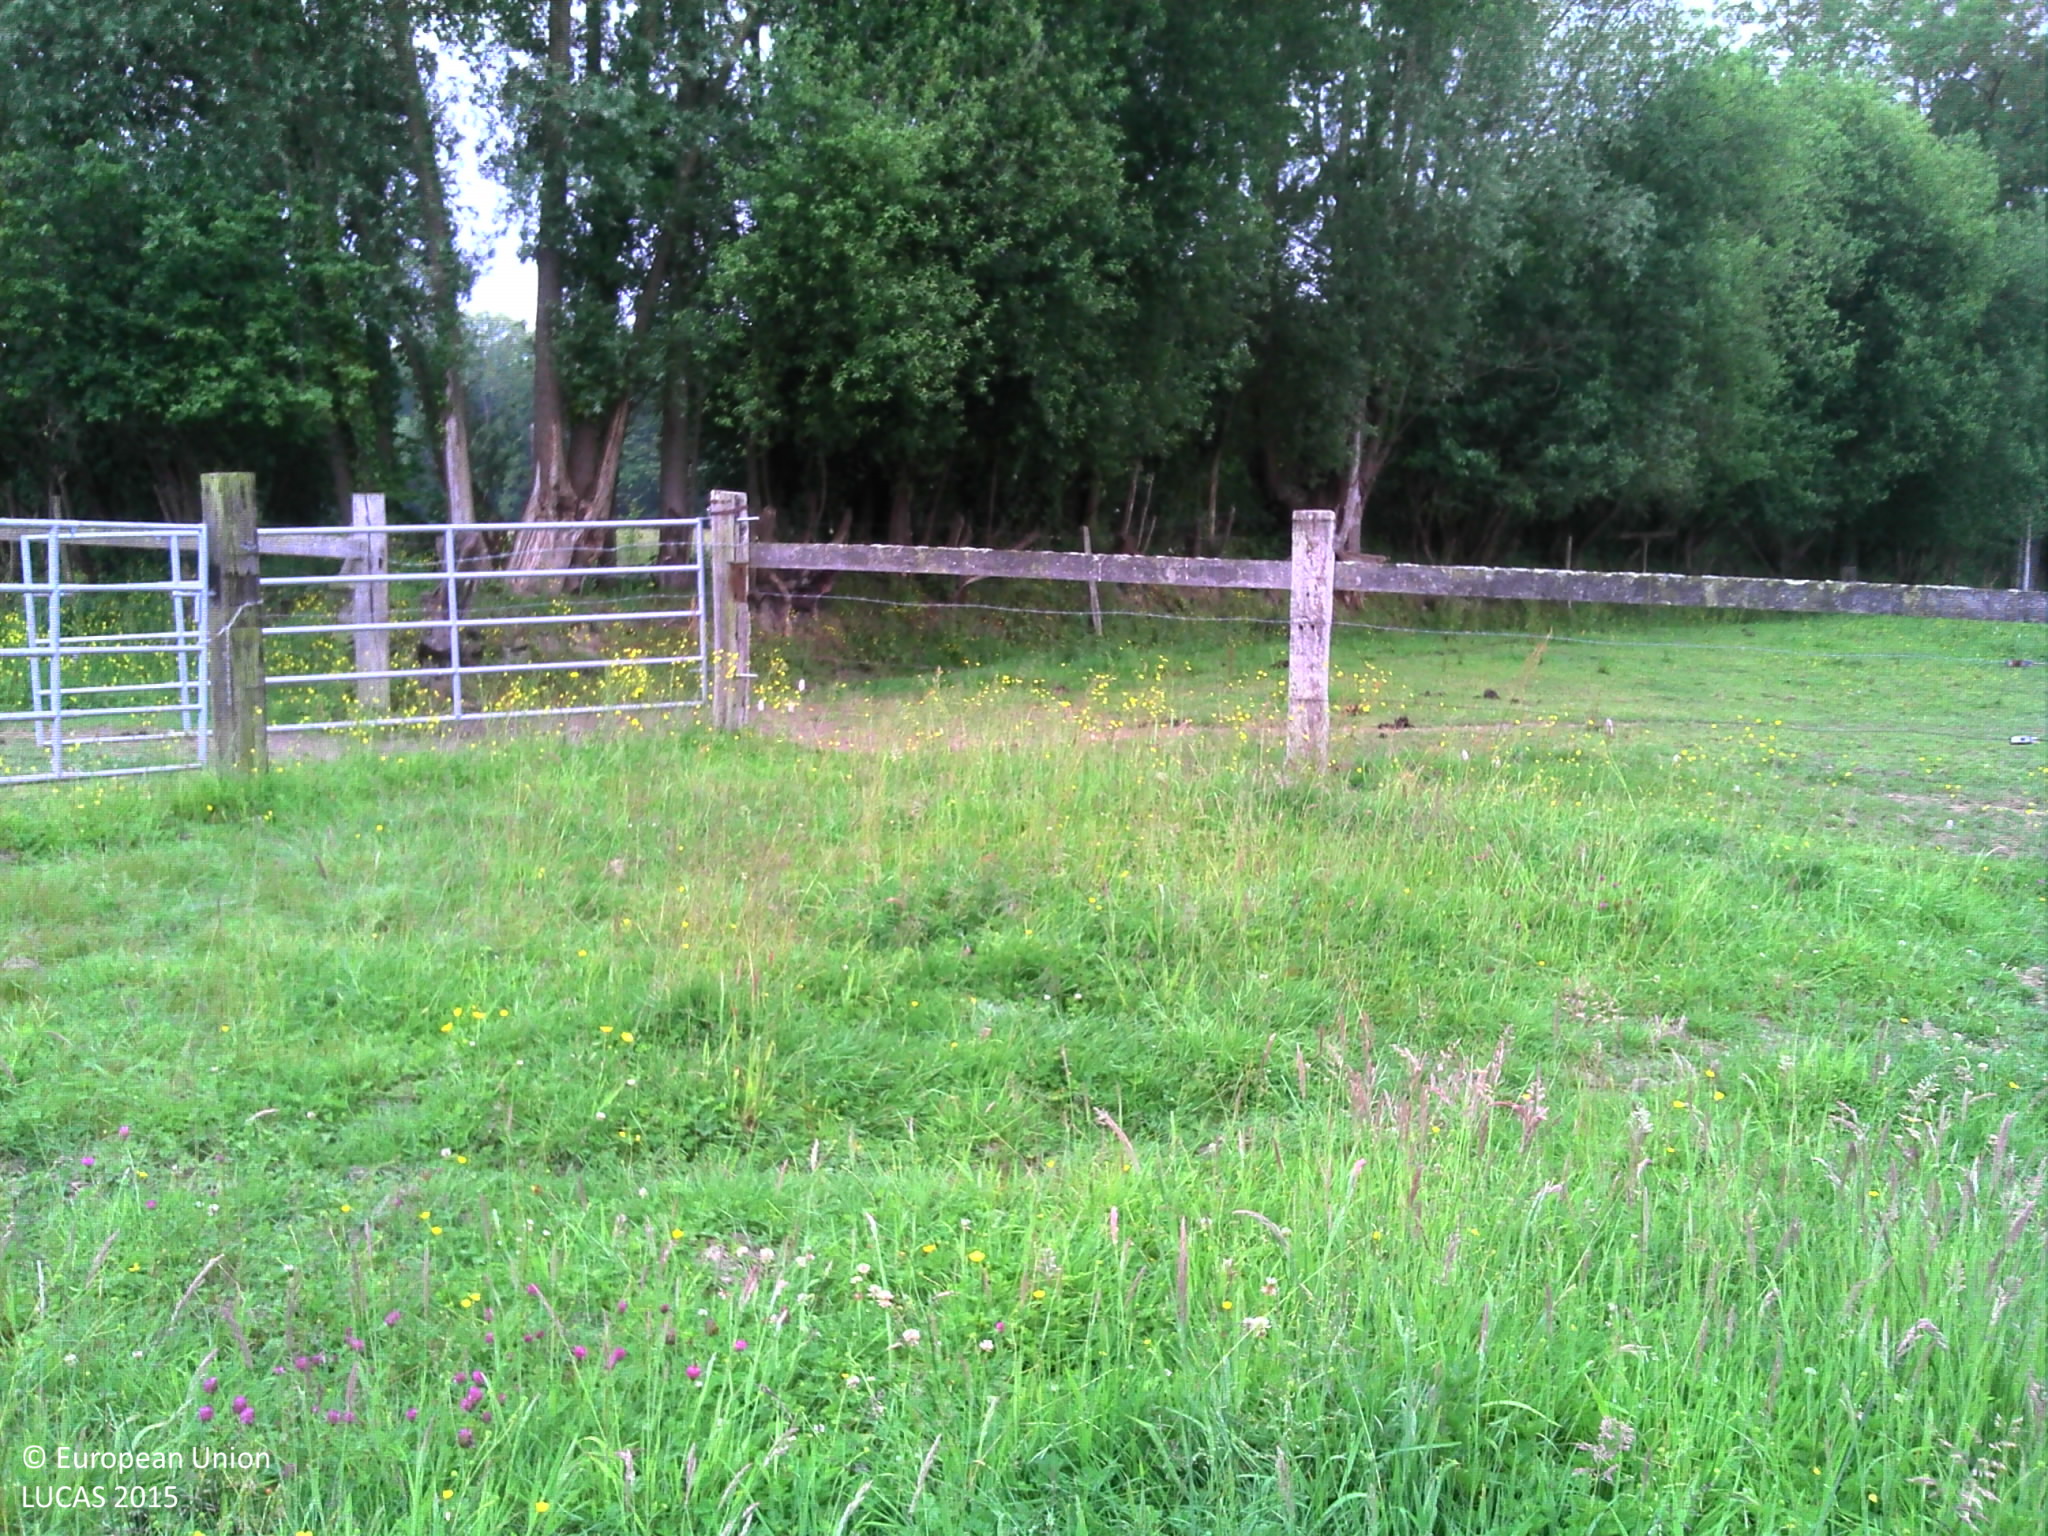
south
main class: Grassland
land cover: Grassland without tree/shrub cover
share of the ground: > 75 %
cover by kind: herbaceous plants 100 %
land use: Agriculture (excluding fallow land and kitchen gardens)
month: June
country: FR
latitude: 49.2347
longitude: -0.0157
